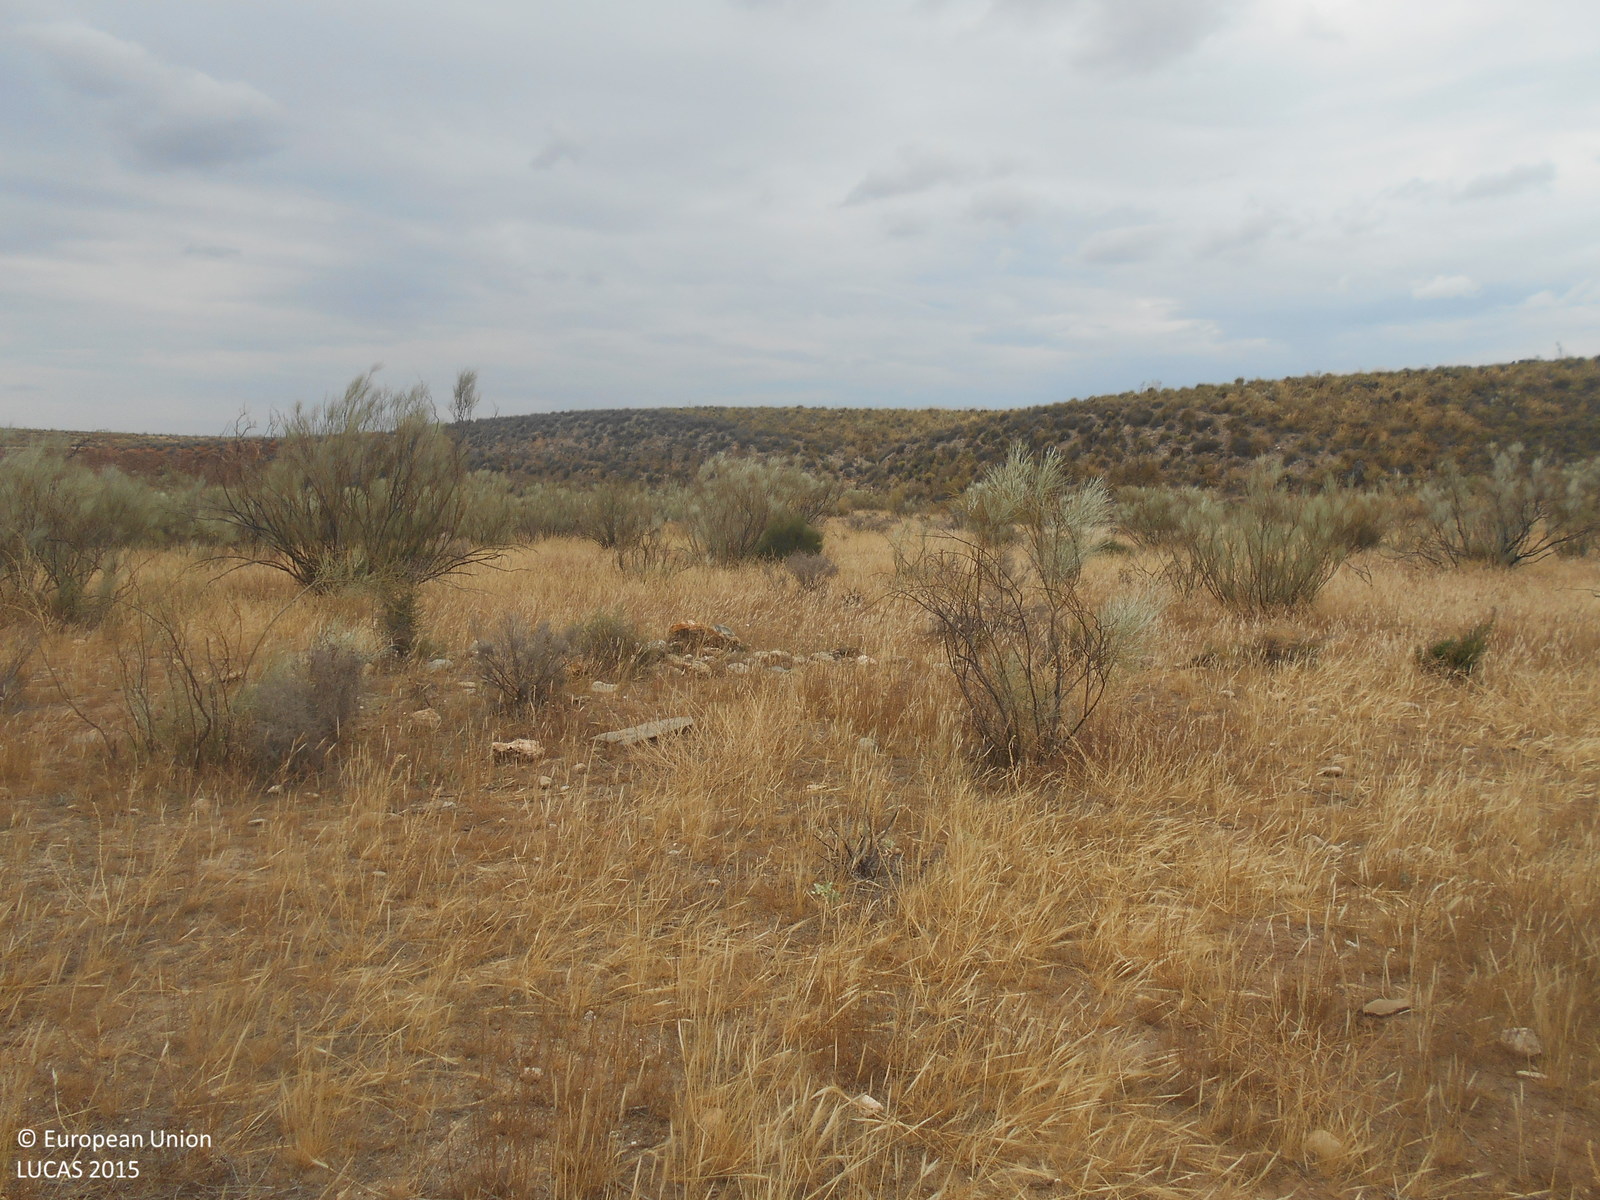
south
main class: Shrubland
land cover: Shrubland without tree cover
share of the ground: 25 - 50 %
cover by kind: herbaceous plants 40 %, unconsolidated bare surface 40 %, shrubs 20 %
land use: Semi-natural and natural areas not in use
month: May
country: ES
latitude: 37.1251
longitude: -2.1899
